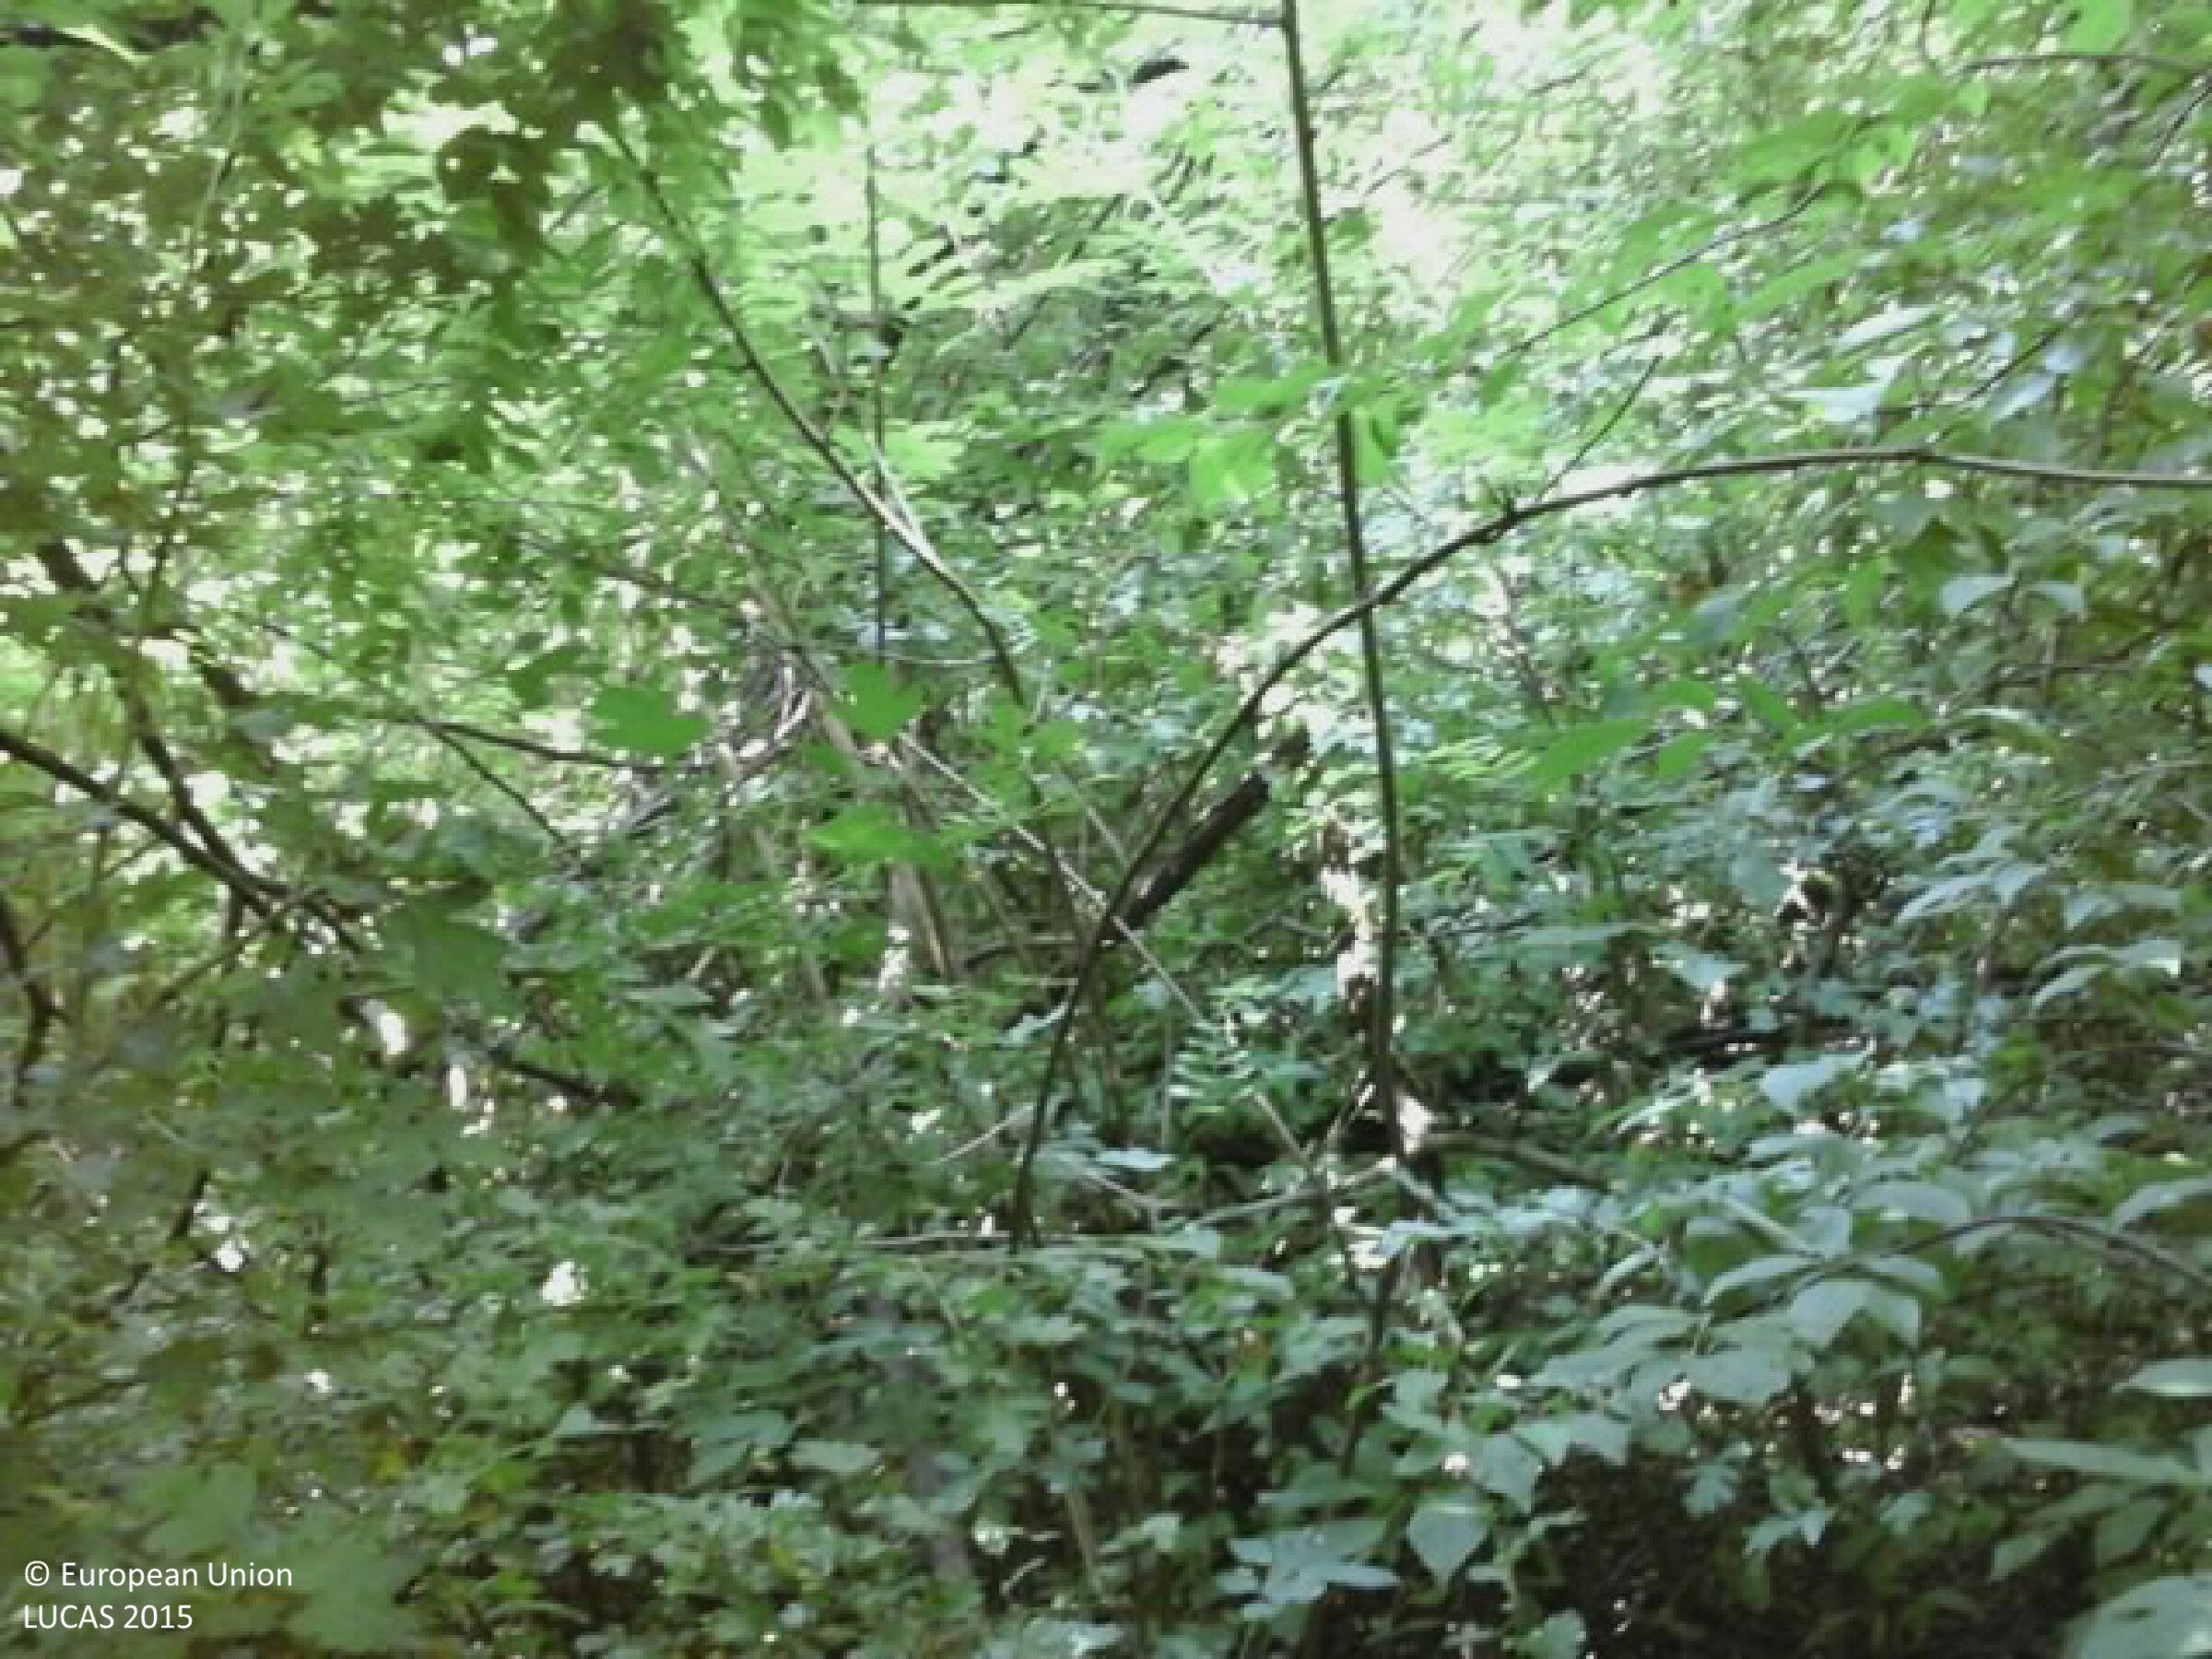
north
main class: Woodland
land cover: Broadleaved woodland
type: mesophytic deciduous forest
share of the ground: > 75 %
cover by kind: broadleaved forest trees 95 %, shrubs 5 %
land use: Forestry
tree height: > 5 m
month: July
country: HU
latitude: 47.6843
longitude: 19.3058
